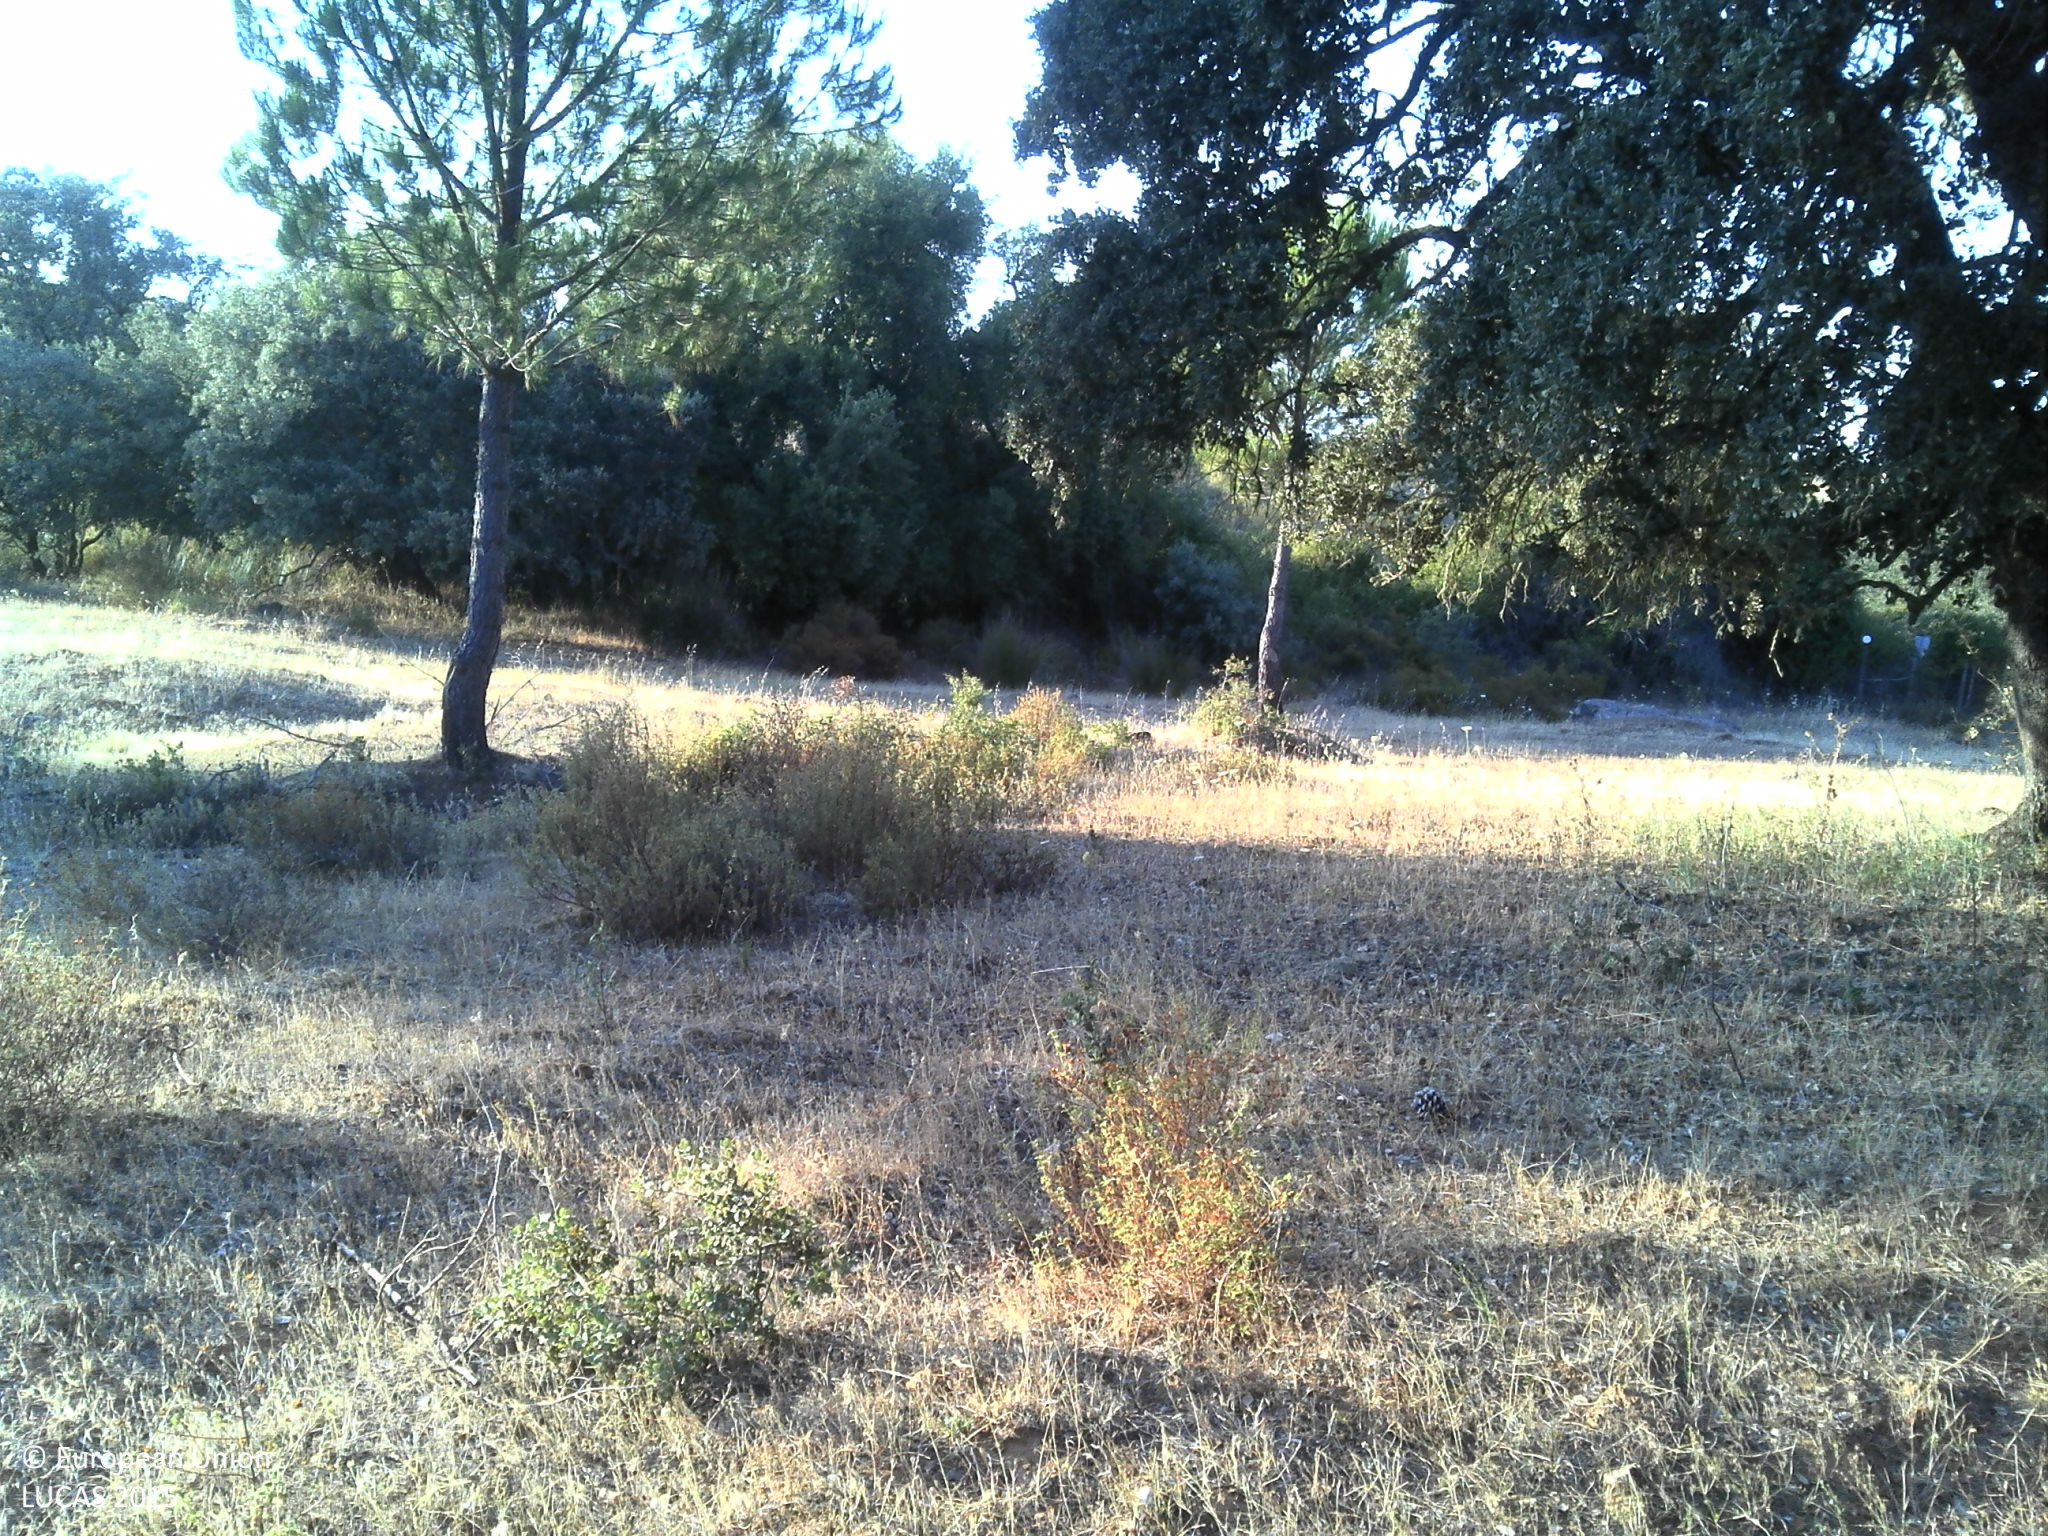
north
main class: Woodland
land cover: Other mixed woodland
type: broadleaved evergreen forest
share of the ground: 50 - 75 %
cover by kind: broadleaved forest trees 50 %, coniferous forest trees 35 %, herbaceous plants 15 %
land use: Forestry
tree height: > 5 m
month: June
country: PT
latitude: 38.0722
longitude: -7.1924
